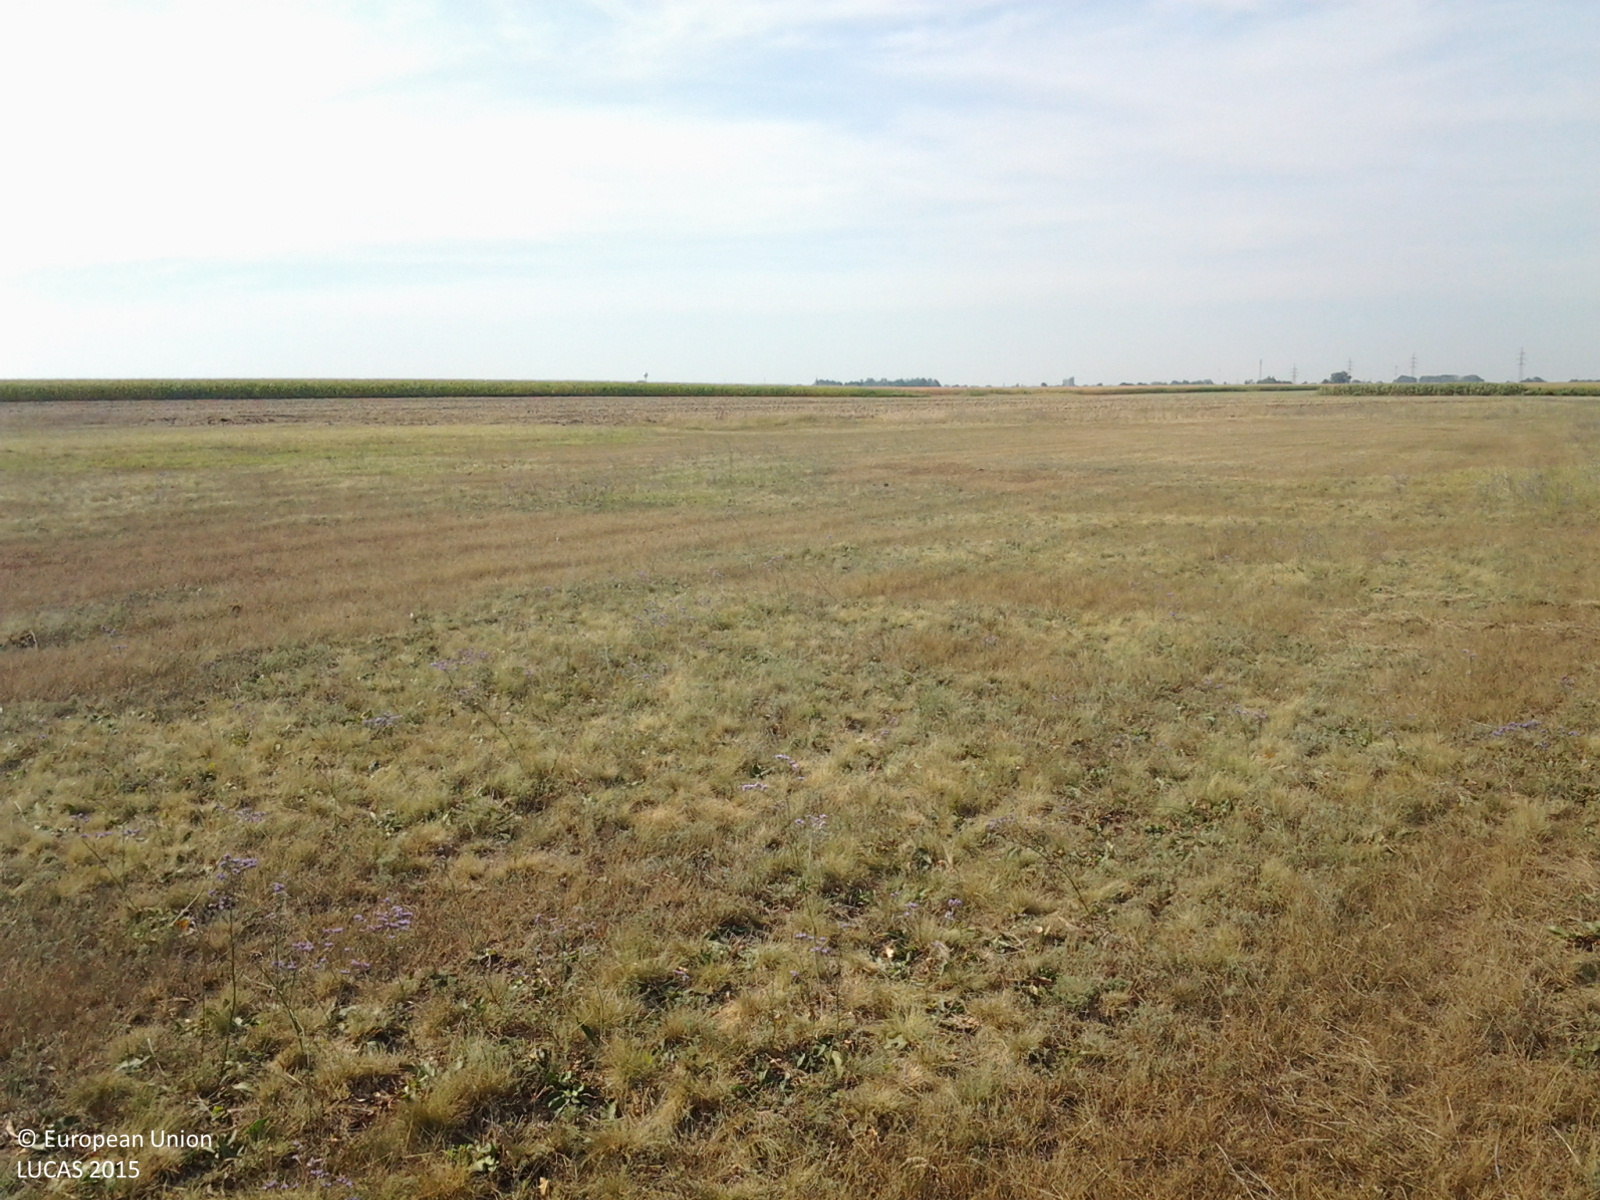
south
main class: Grassland
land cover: Grassland without tree/shrub cover
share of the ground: > 75 %
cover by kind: herbaceous plants 100 %
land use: Agriculture (excluding fallow land and kitchen gardens)
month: August
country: HU
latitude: 47.4465
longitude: 19.7443
